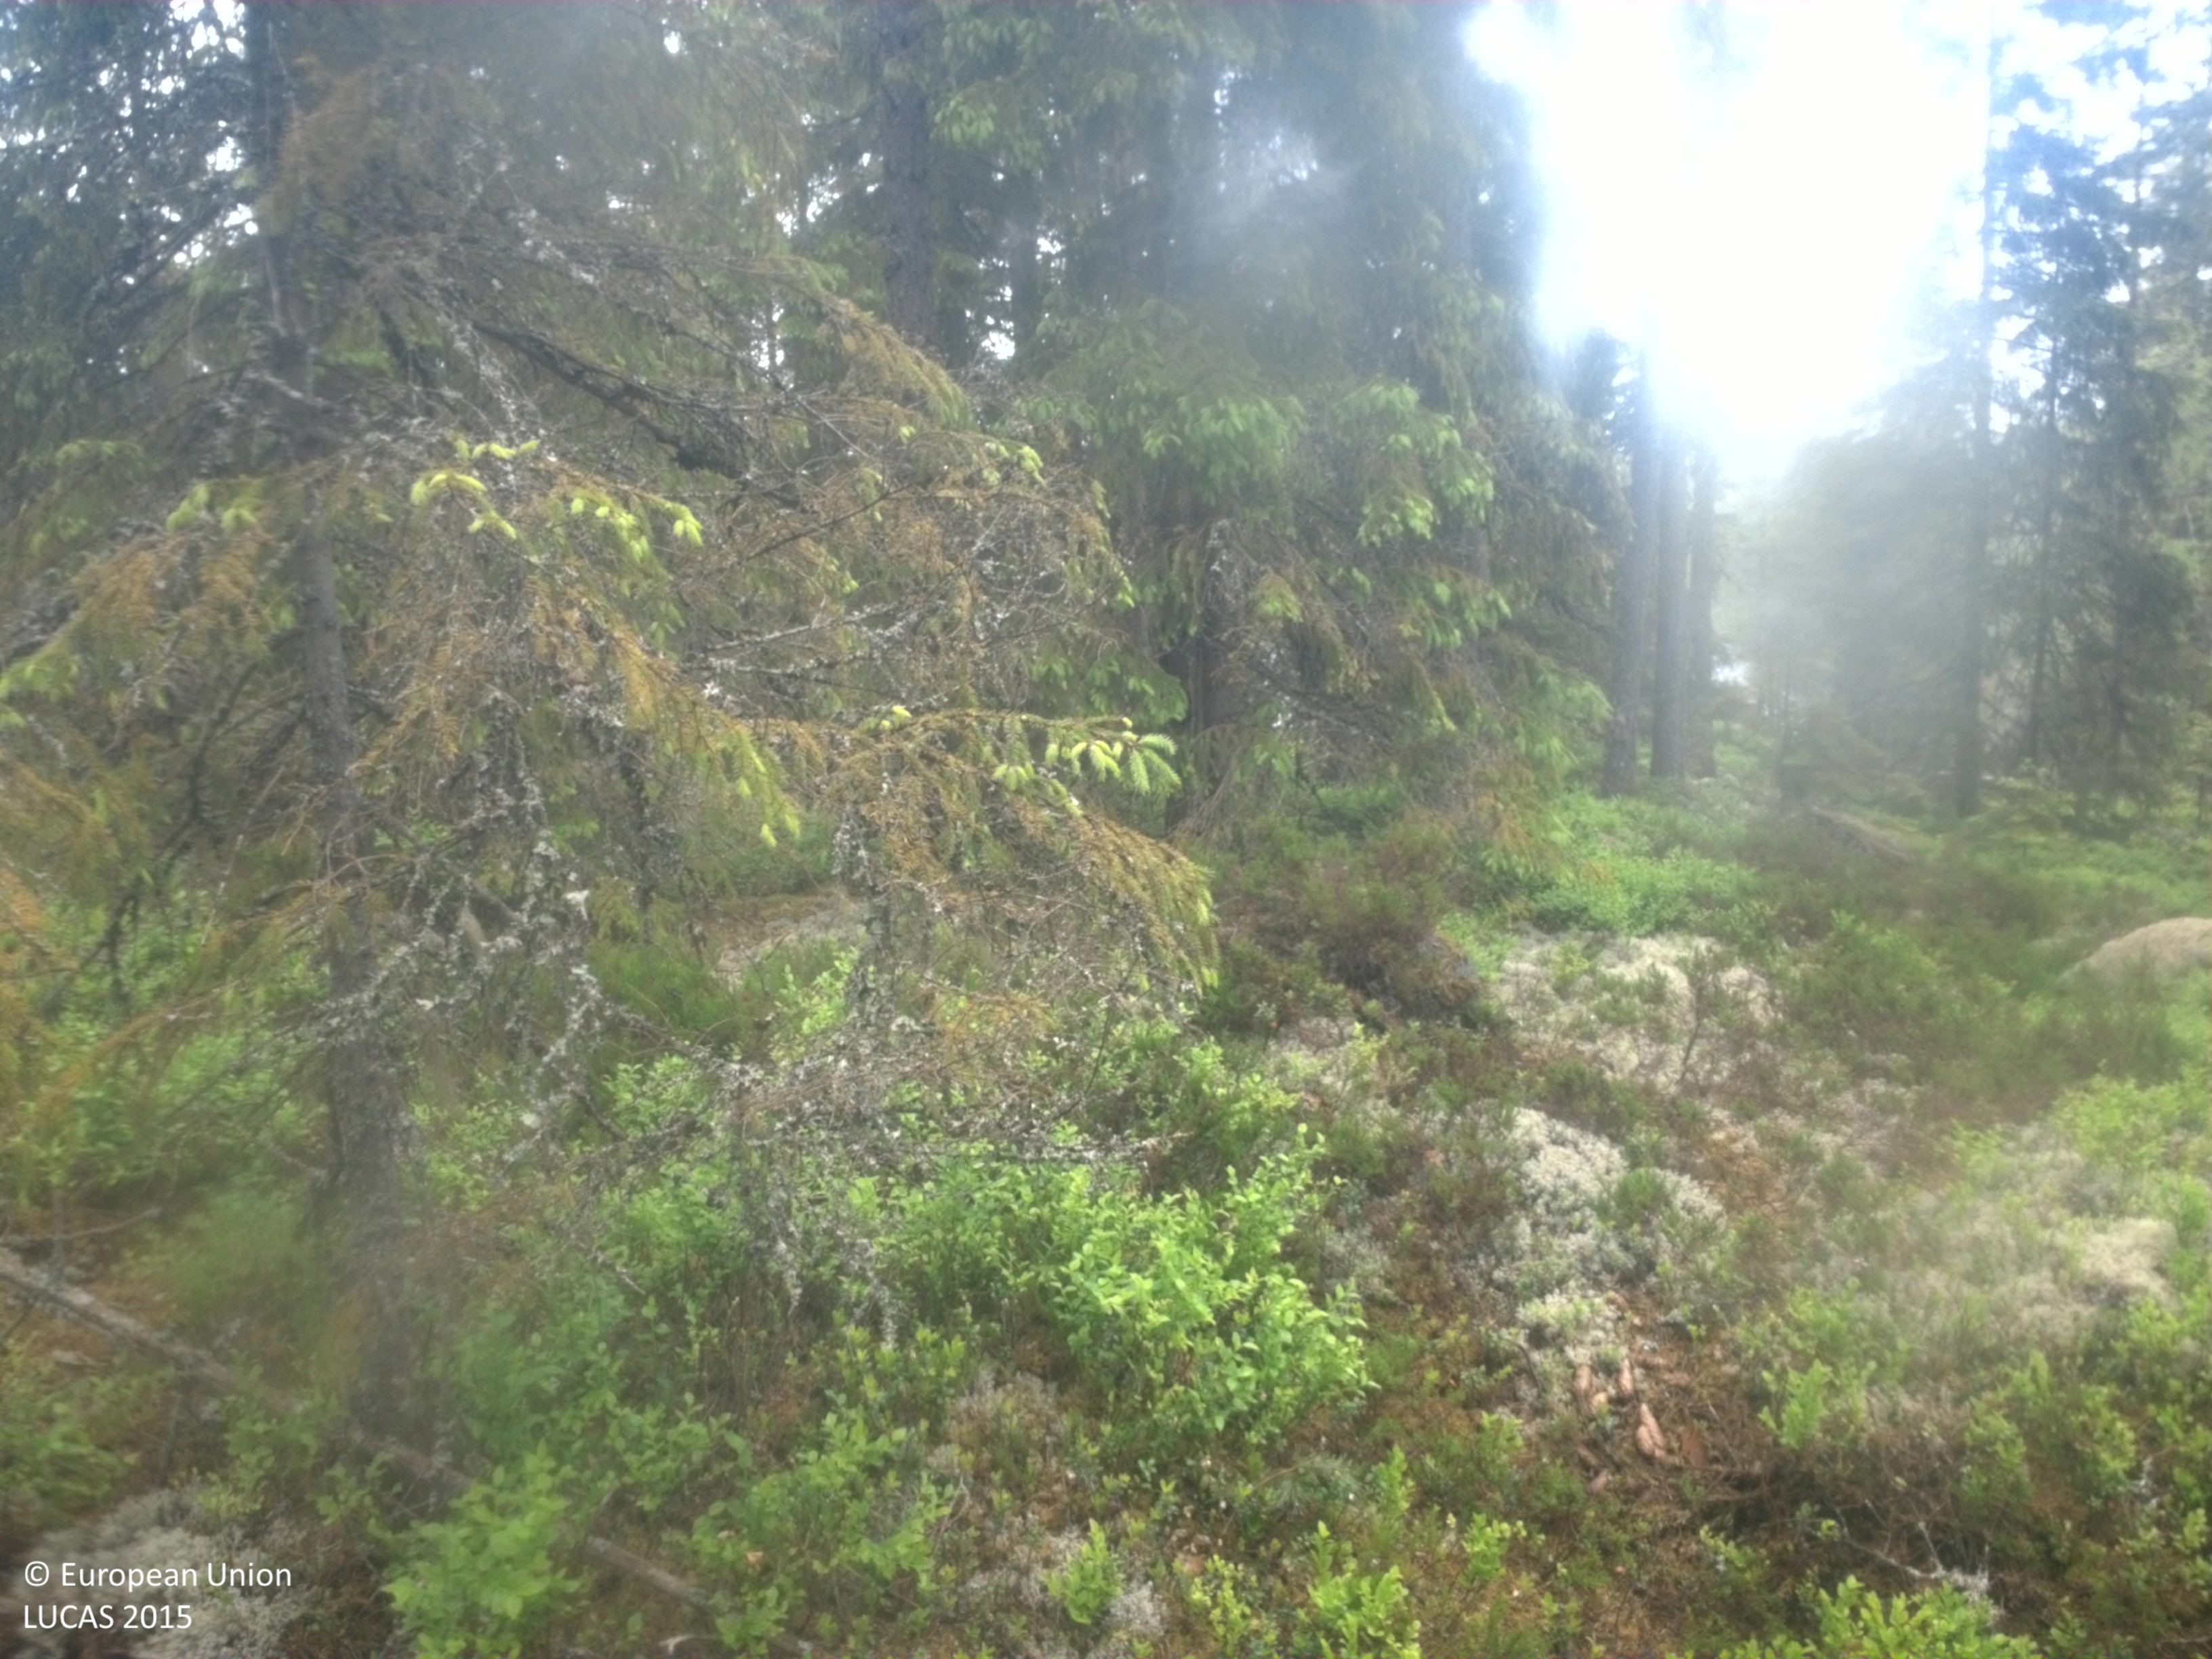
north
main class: Woodland
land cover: Other coniferous woodland
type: boreal forest
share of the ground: 50 - 75 %
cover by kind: coniferous forest trees 60 %, shrubs 20 %, herbaceous plants 10 %, lichens and mosses 5 %, consolidated bare surface 5 %
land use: Forestry
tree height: > 5 m
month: June
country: SE
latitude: 59.4815
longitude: 14.3871
